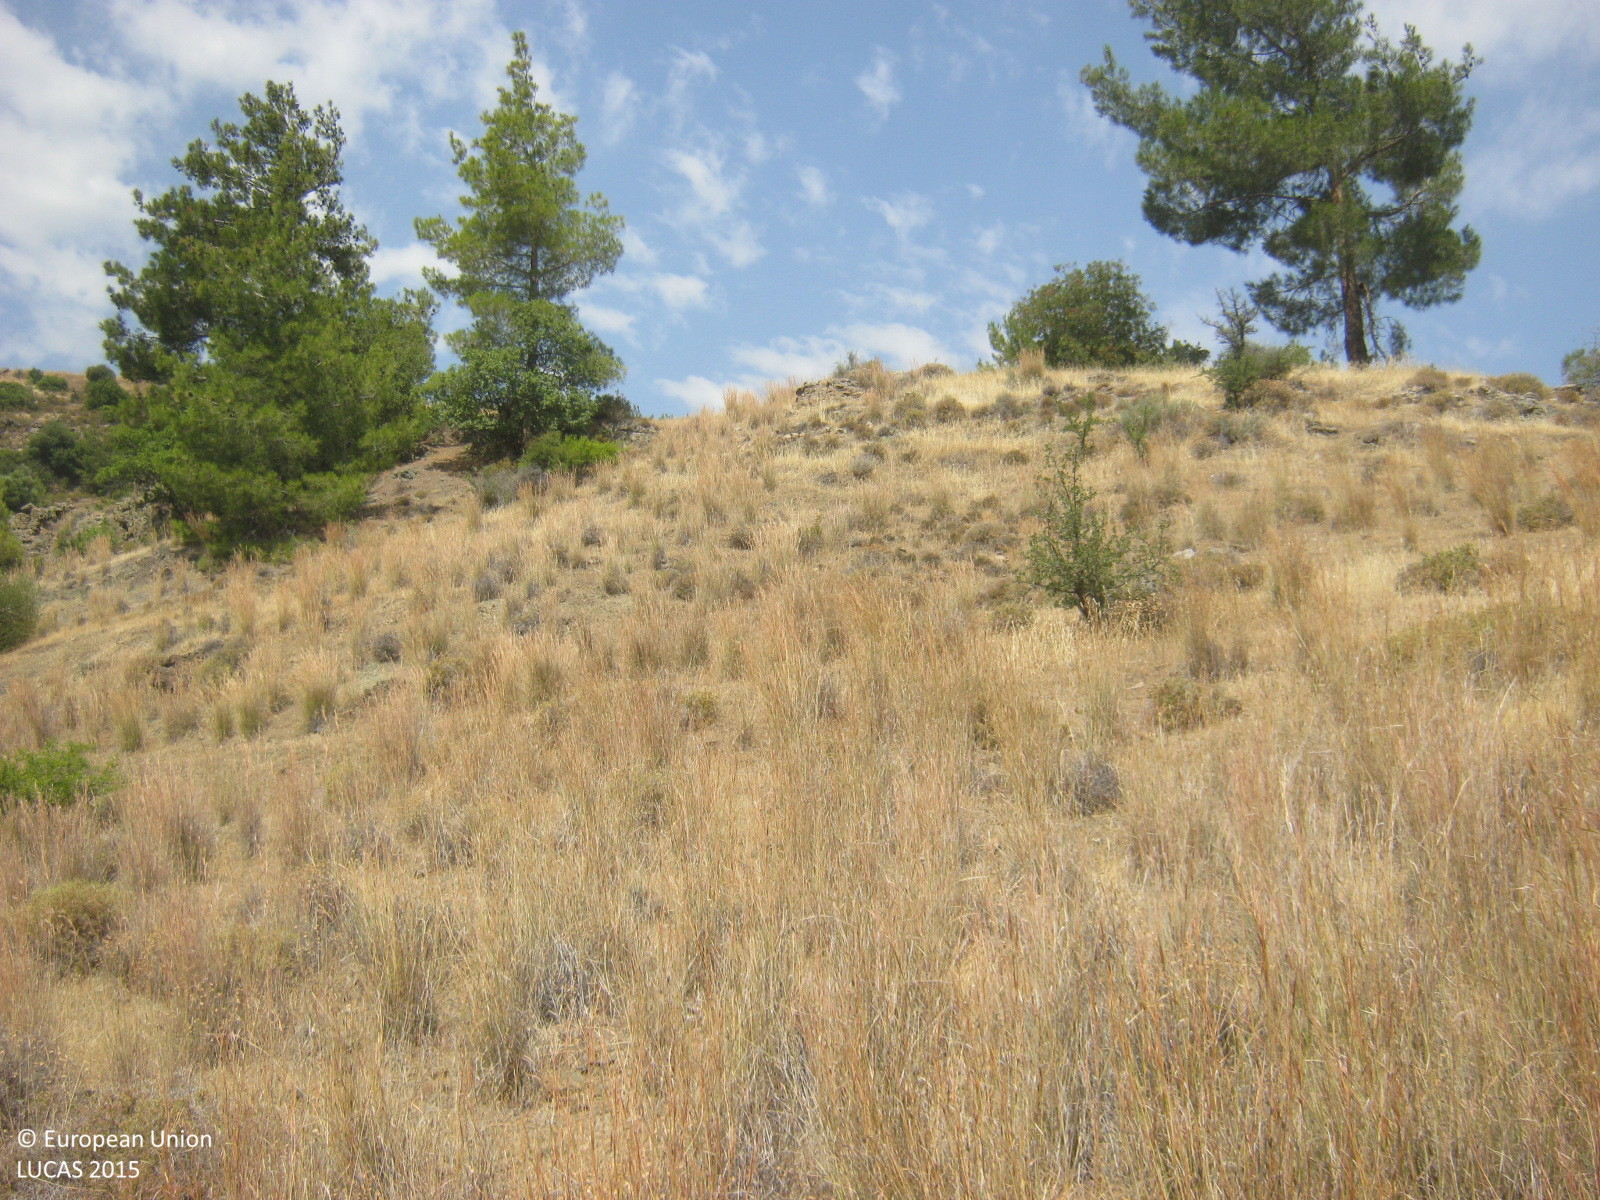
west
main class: Shrubland
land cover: Shrubland without tree cover
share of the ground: 10 - 25 %
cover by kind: herbaceous plants 70 %, shrubs 25 %, unconsolidated bare surface 5 %
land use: Semi-natural and natural areas not in use
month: June
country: CY
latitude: 35.0357
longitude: 33.0082
